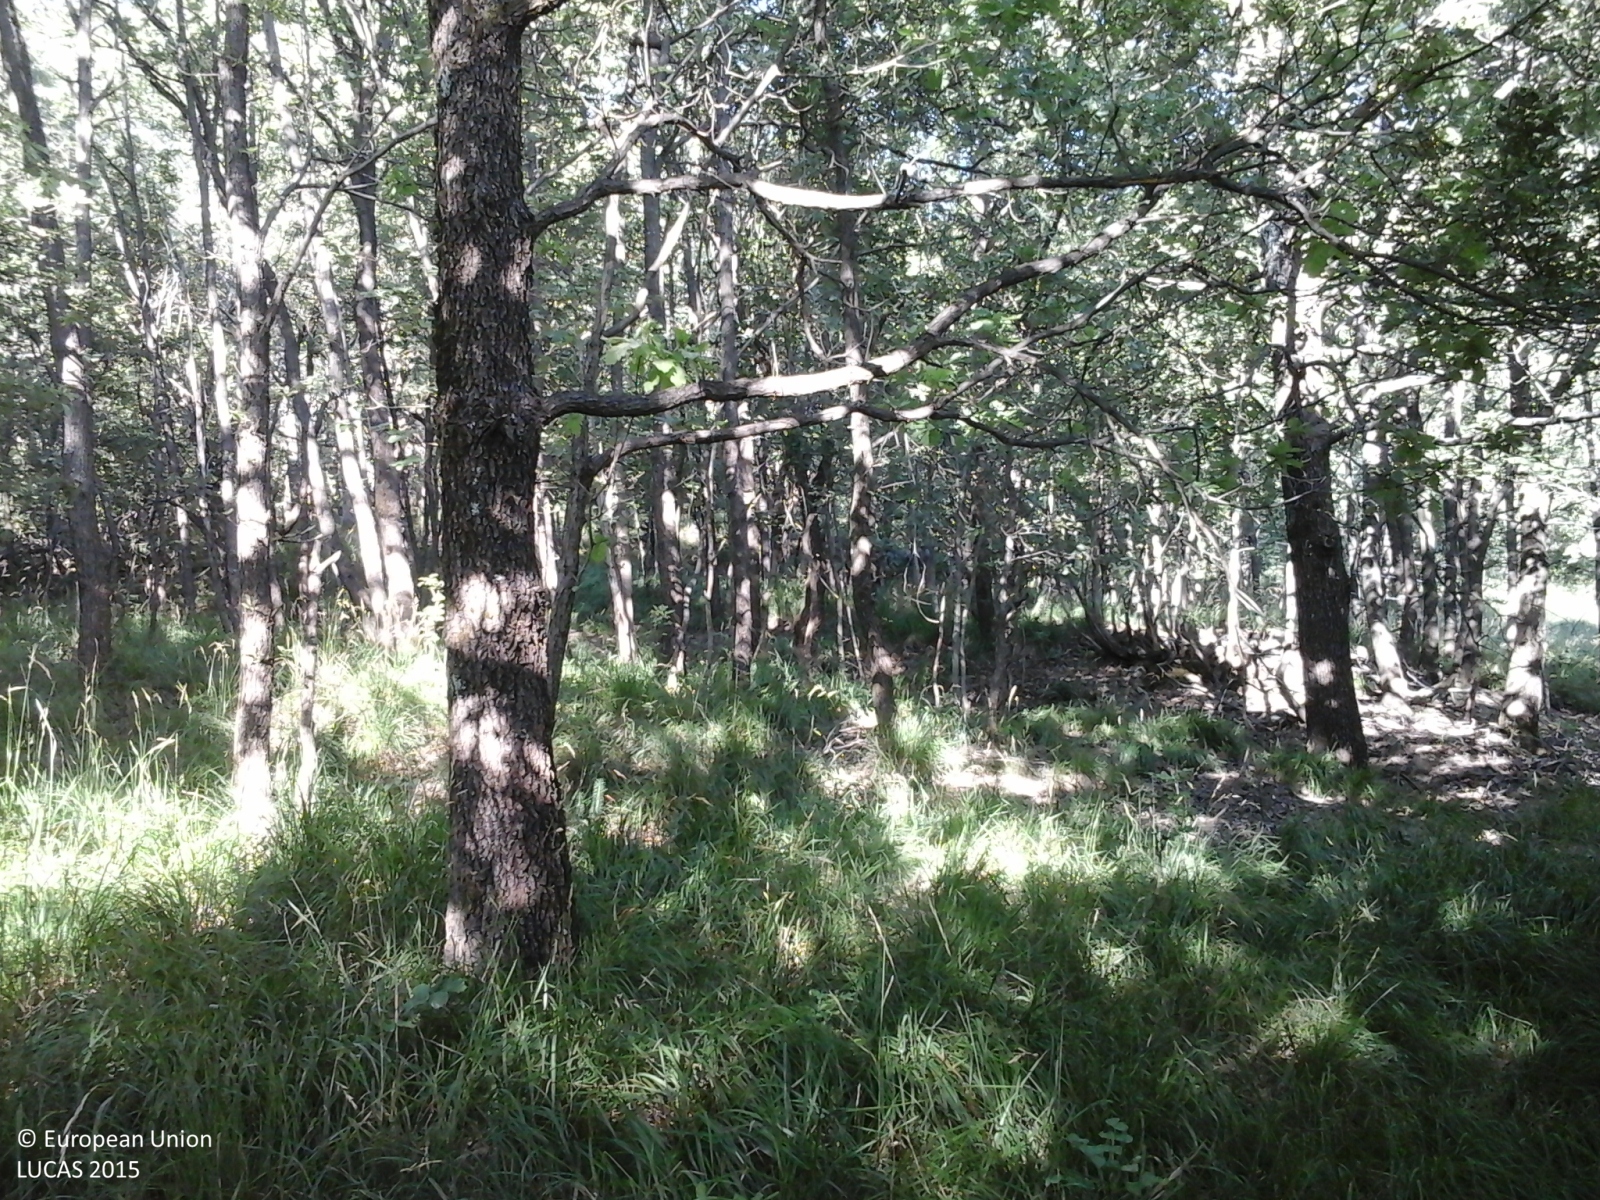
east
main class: Woodland
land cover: Broadleaved woodland
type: thermophilous deciduous forest
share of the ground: > 75 %
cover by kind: broadleaved forest trees 100 %
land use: Forestry
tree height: > 5 m
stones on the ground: < 10 %
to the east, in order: Broadleaved woodland; Fences; Broadleaved woodland; Tracks; Broadleaved woodland
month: June
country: IT
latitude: 44.6323
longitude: 8.8050
